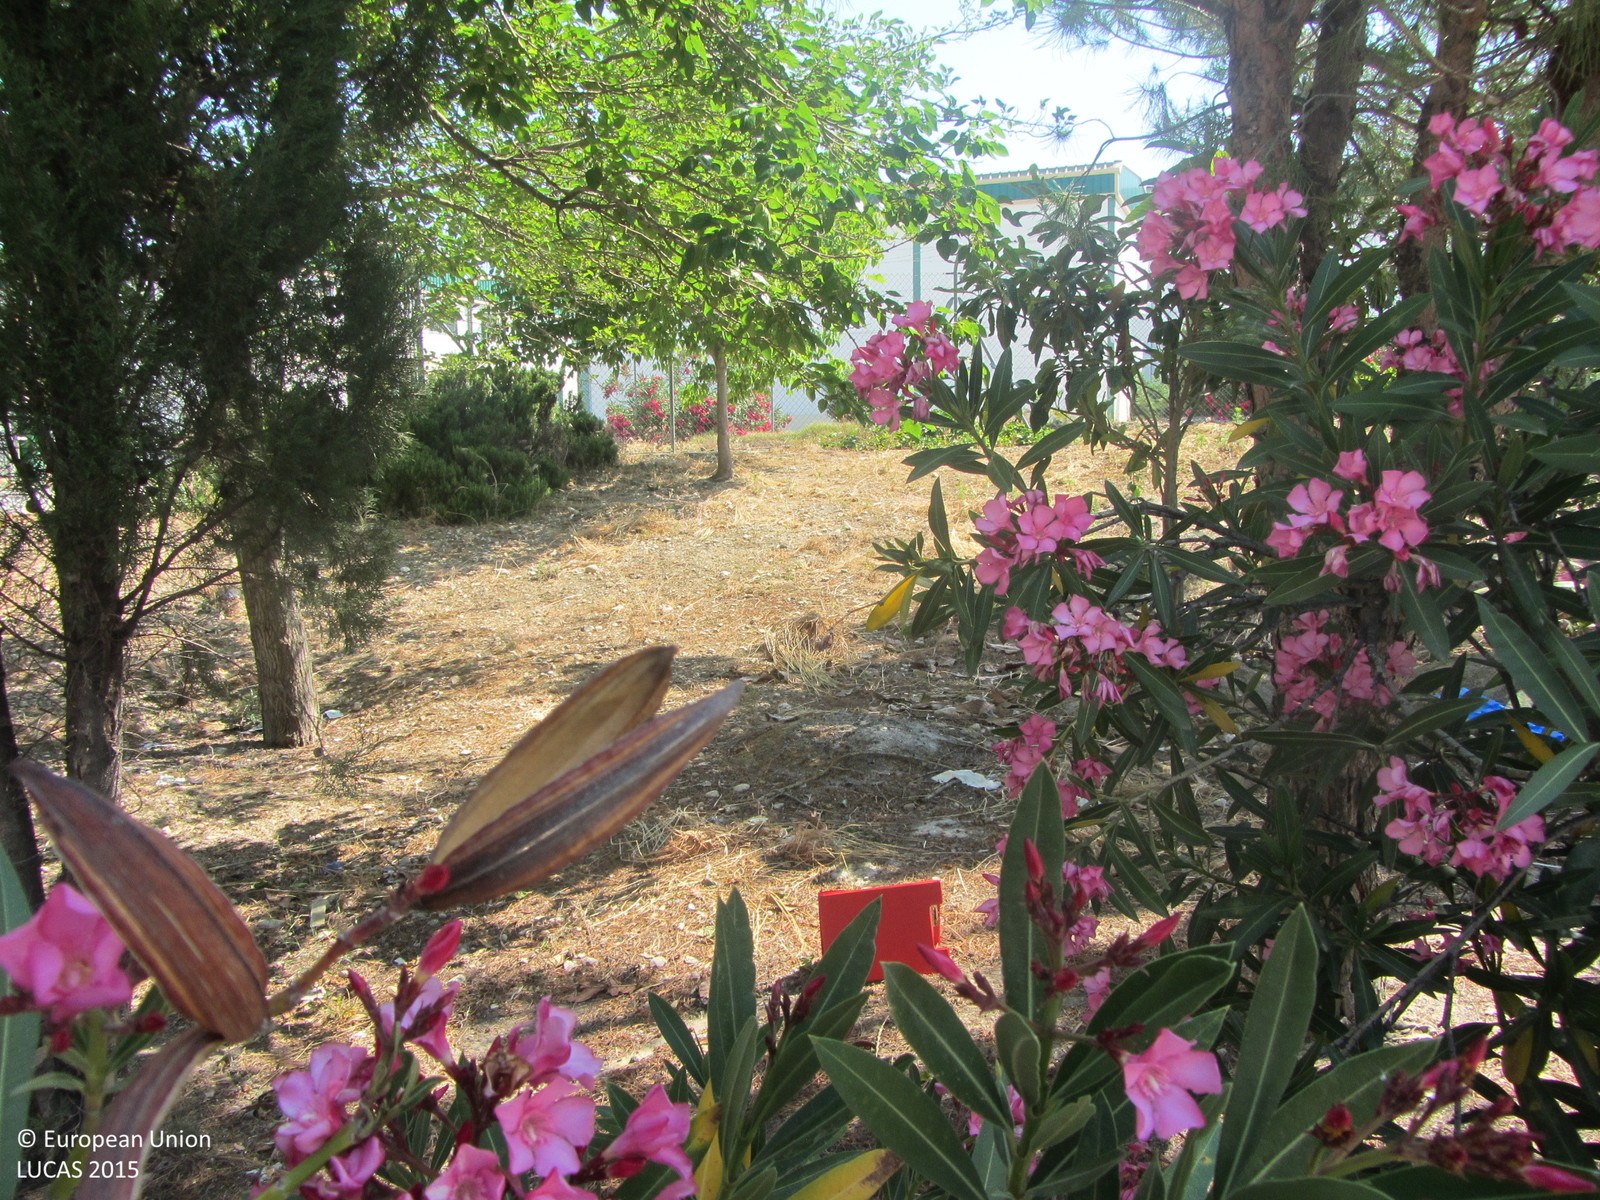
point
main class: Woodland
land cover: Pine dominated mixed woodland
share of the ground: 25 - 50 %
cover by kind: consolidated bare surface 70 %, coniferous forest trees 15 %, broadleaved forest trees 15 %
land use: Community services
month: May
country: ES
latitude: 38.0259
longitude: -3.3859
